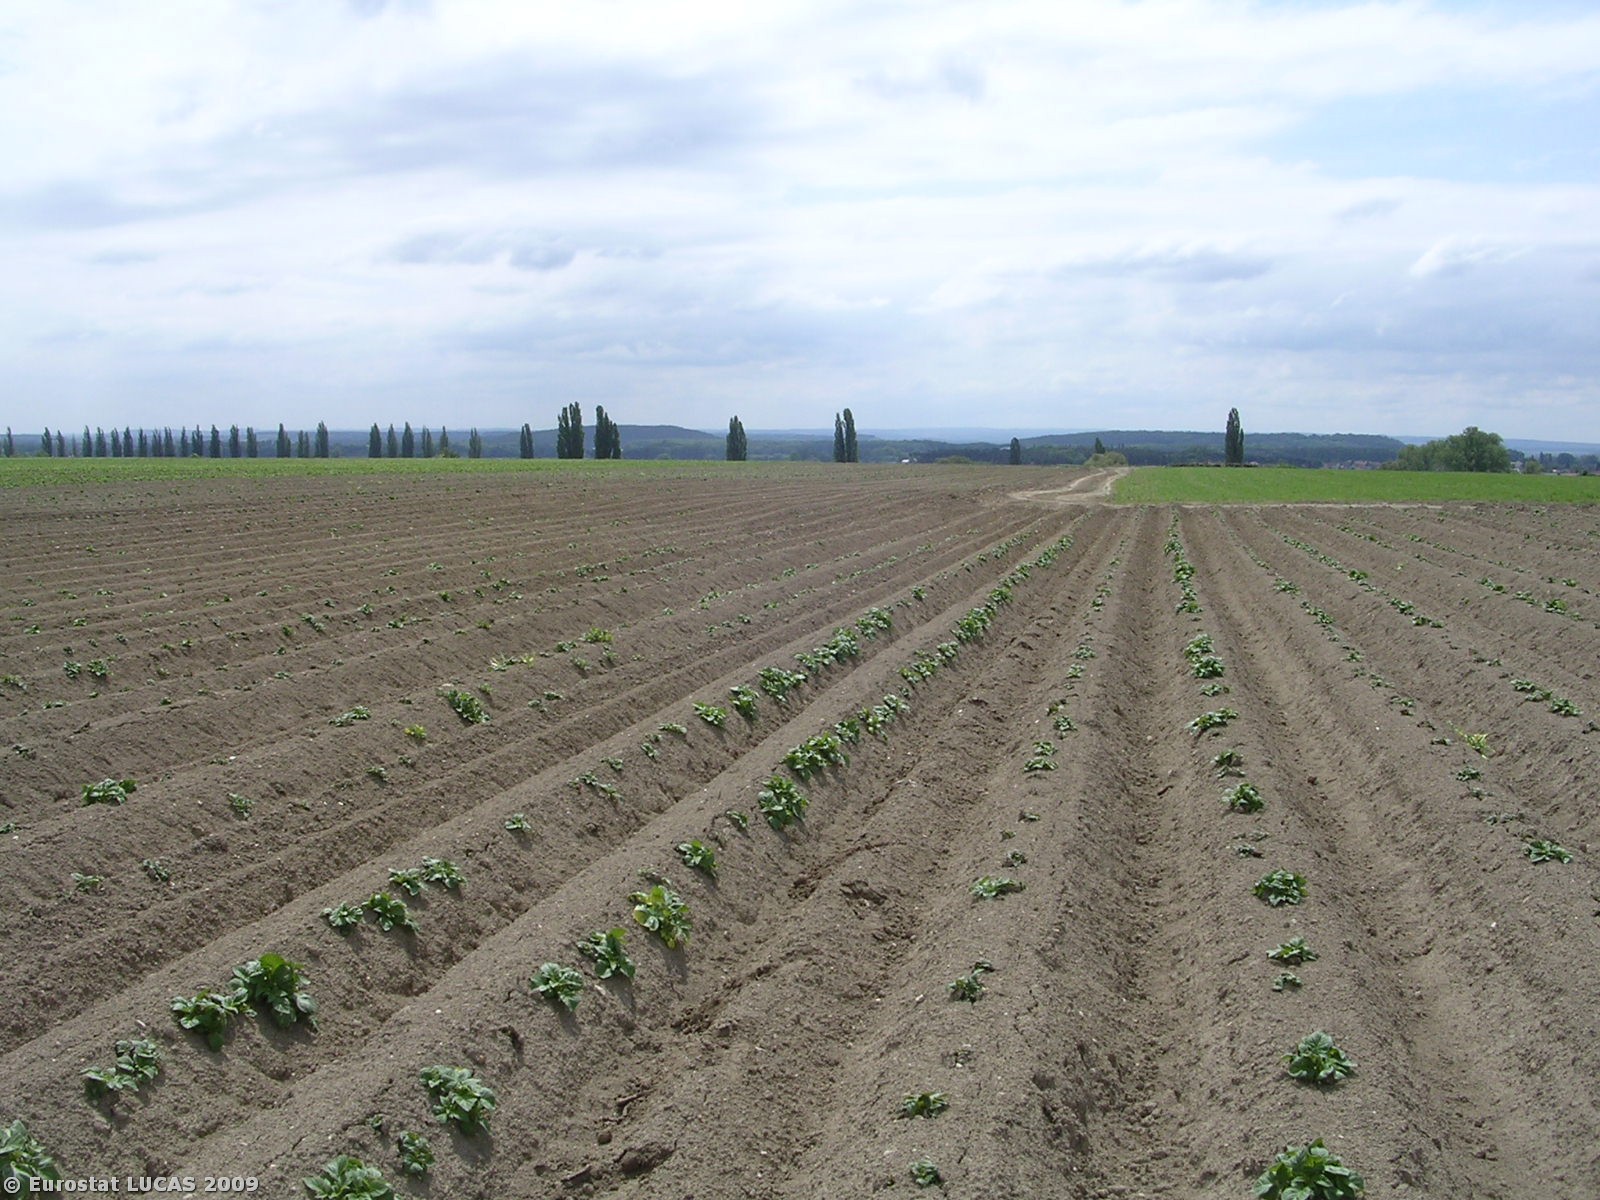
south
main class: Cropland
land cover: Potatoes
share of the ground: 10 - 25 %
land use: Agriculture (excluding fallow land and kitchen gardens)
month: May
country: CZ
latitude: 50.2066
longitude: 14.8644
